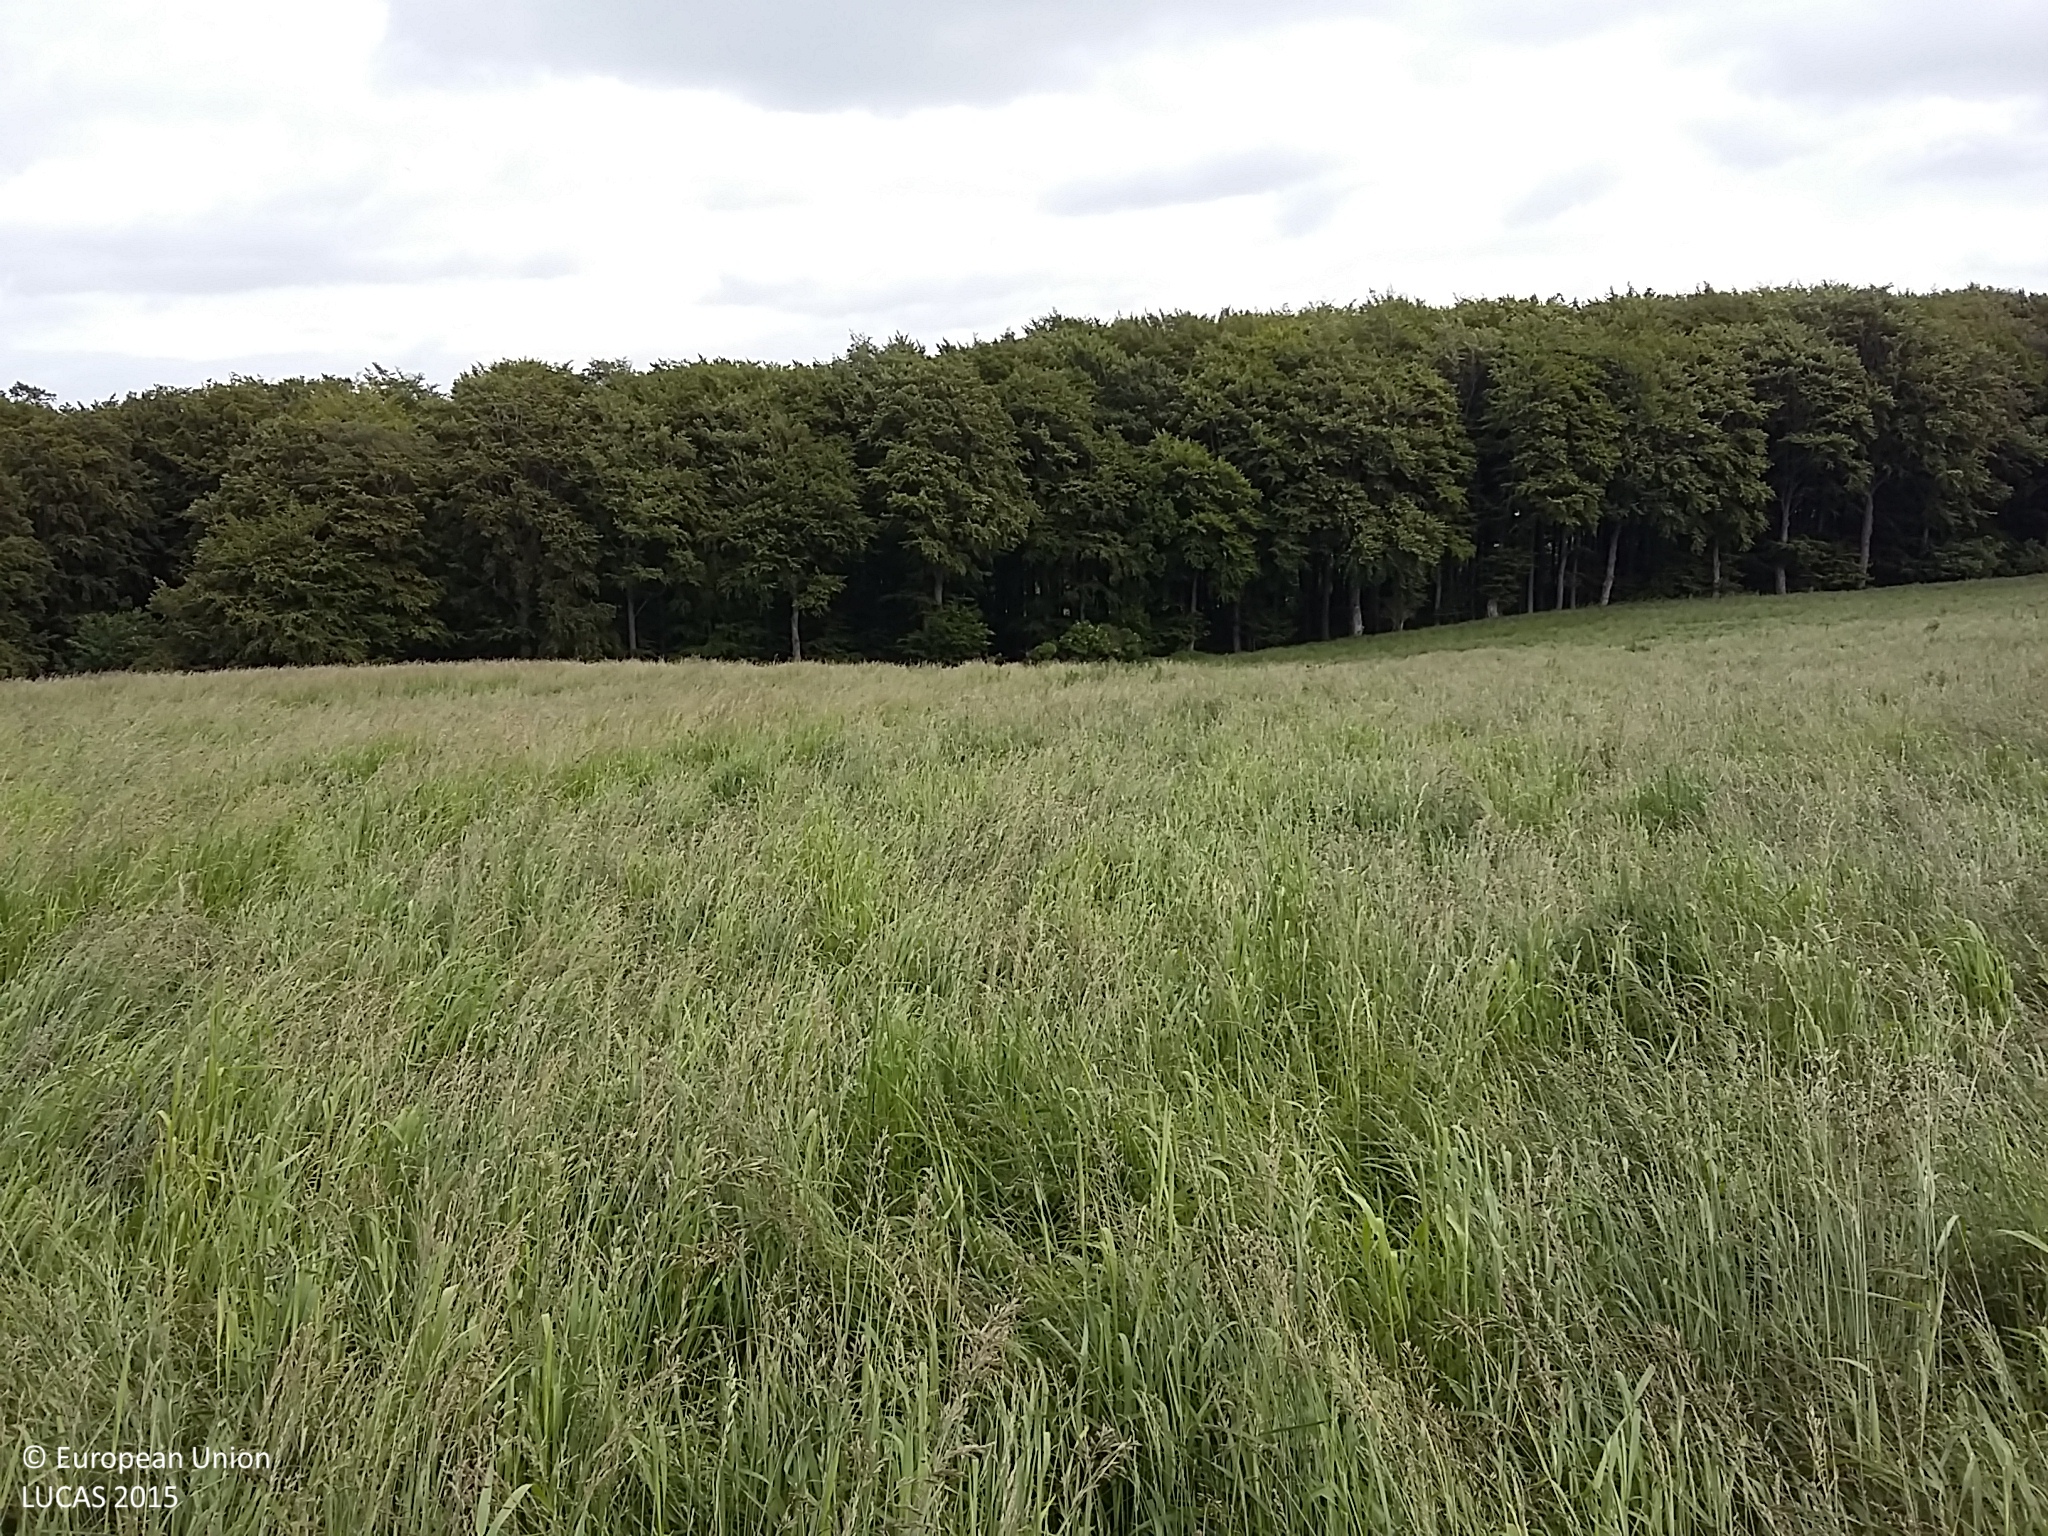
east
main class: Cropland
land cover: Temporary grasslands
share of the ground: > 75 %
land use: Agriculture (excluding fallow land and kitchen gardens)
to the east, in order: Temporary grasslands; Broadleaved woodland; Tracks; Broadleaved woodland
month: June
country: DK
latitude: 55.2687
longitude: 10.7705
